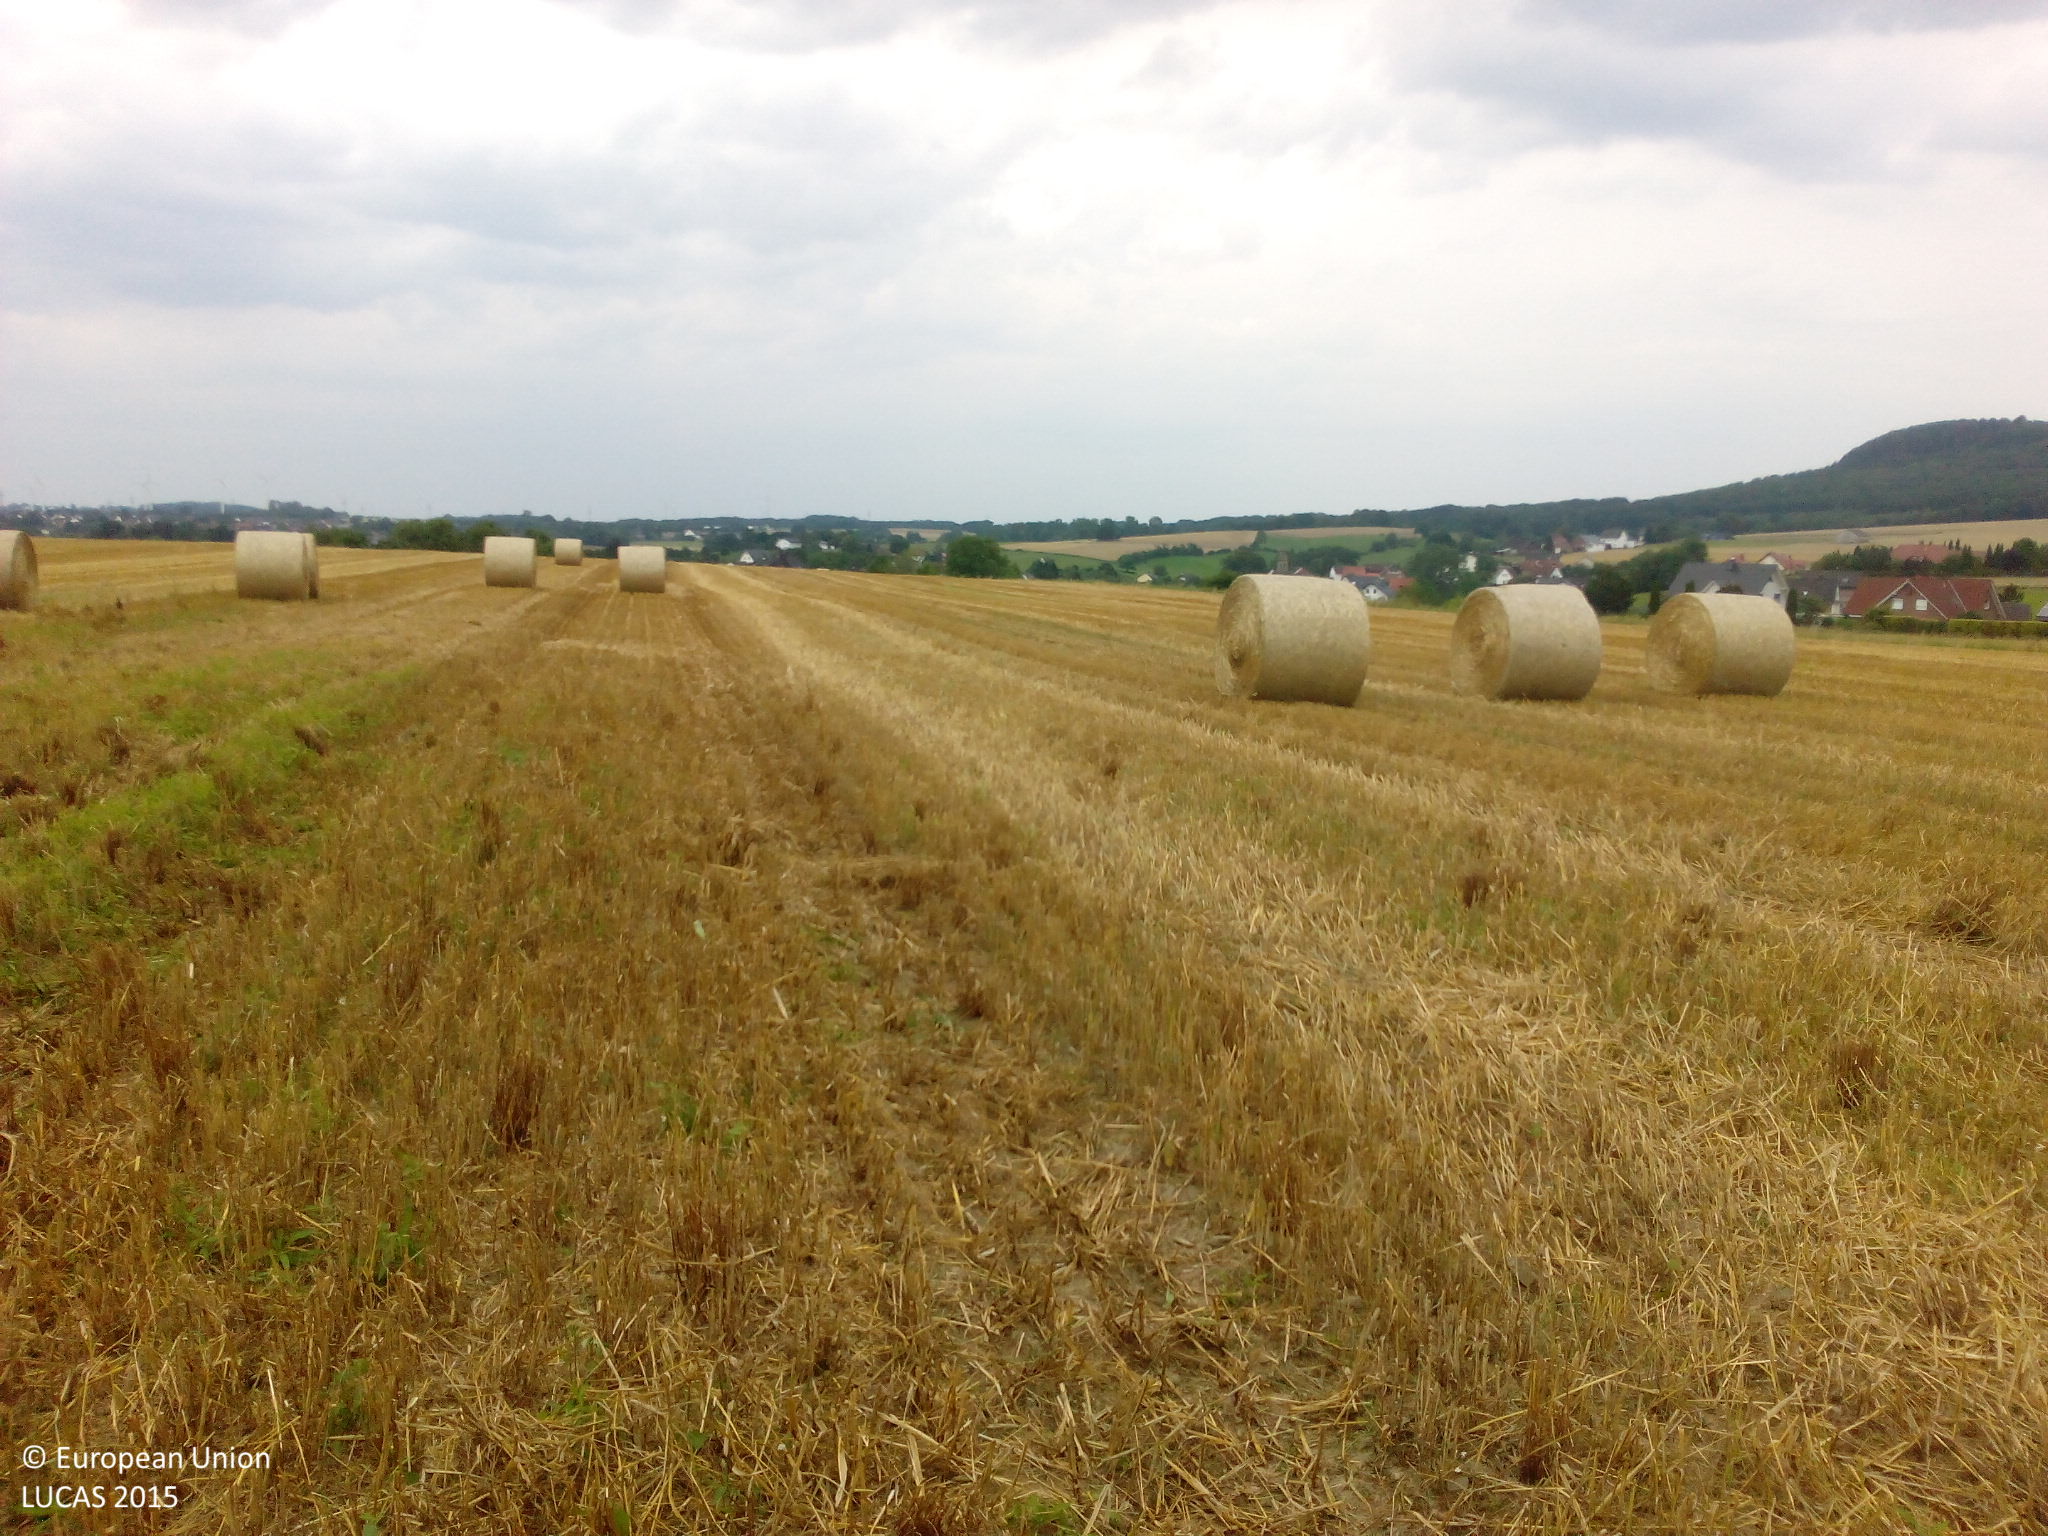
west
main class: Cropland
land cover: Barley
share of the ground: < 10 %
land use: Agriculture (excluding fallow land and kitchen gardens)
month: August
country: DE
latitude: 51.8364
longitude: 9.3471
